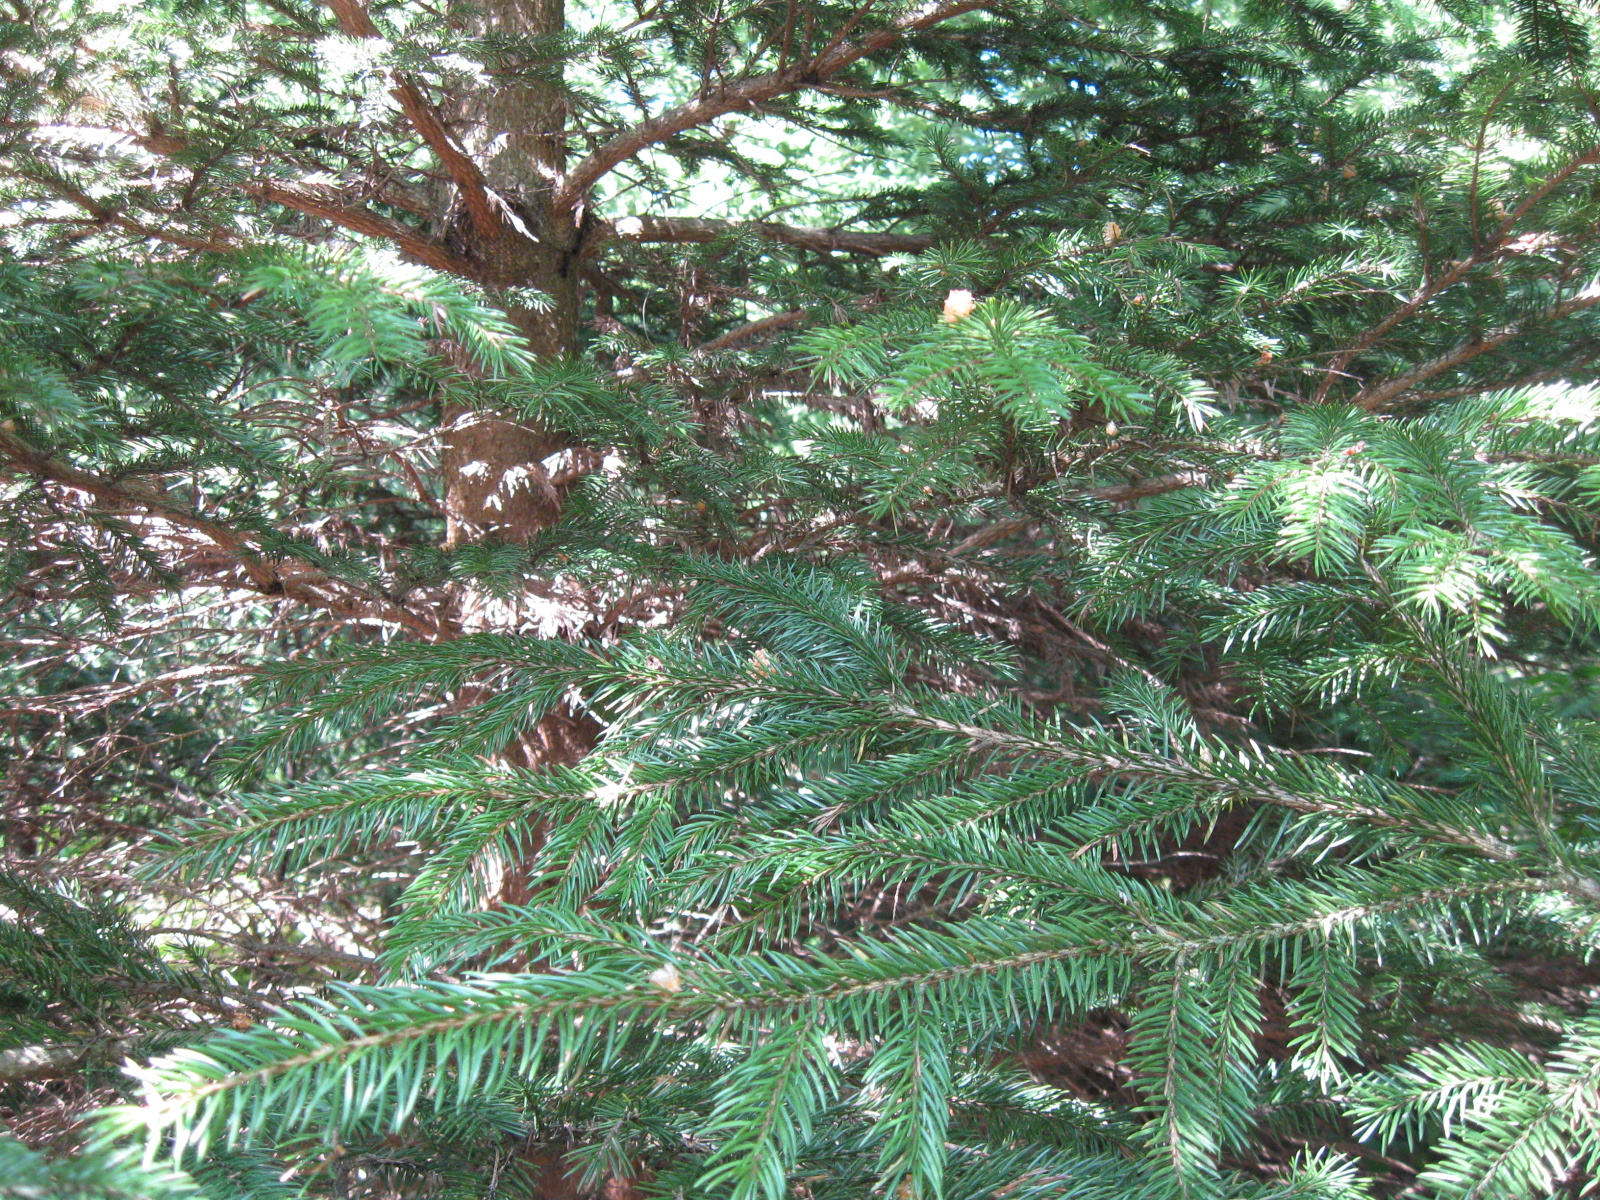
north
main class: Woodland
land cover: Spruce dominated mixed woodland
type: hemiboreal forest and nemoral coniferous forest and mixed broadleaved-coniferous forest
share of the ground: > 75 %
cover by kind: coniferous forest trees 75 %, broadleaved forest trees 25 %
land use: Forestry
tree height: > 5 m
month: May
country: LT
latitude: 54.2690
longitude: 23.2990
